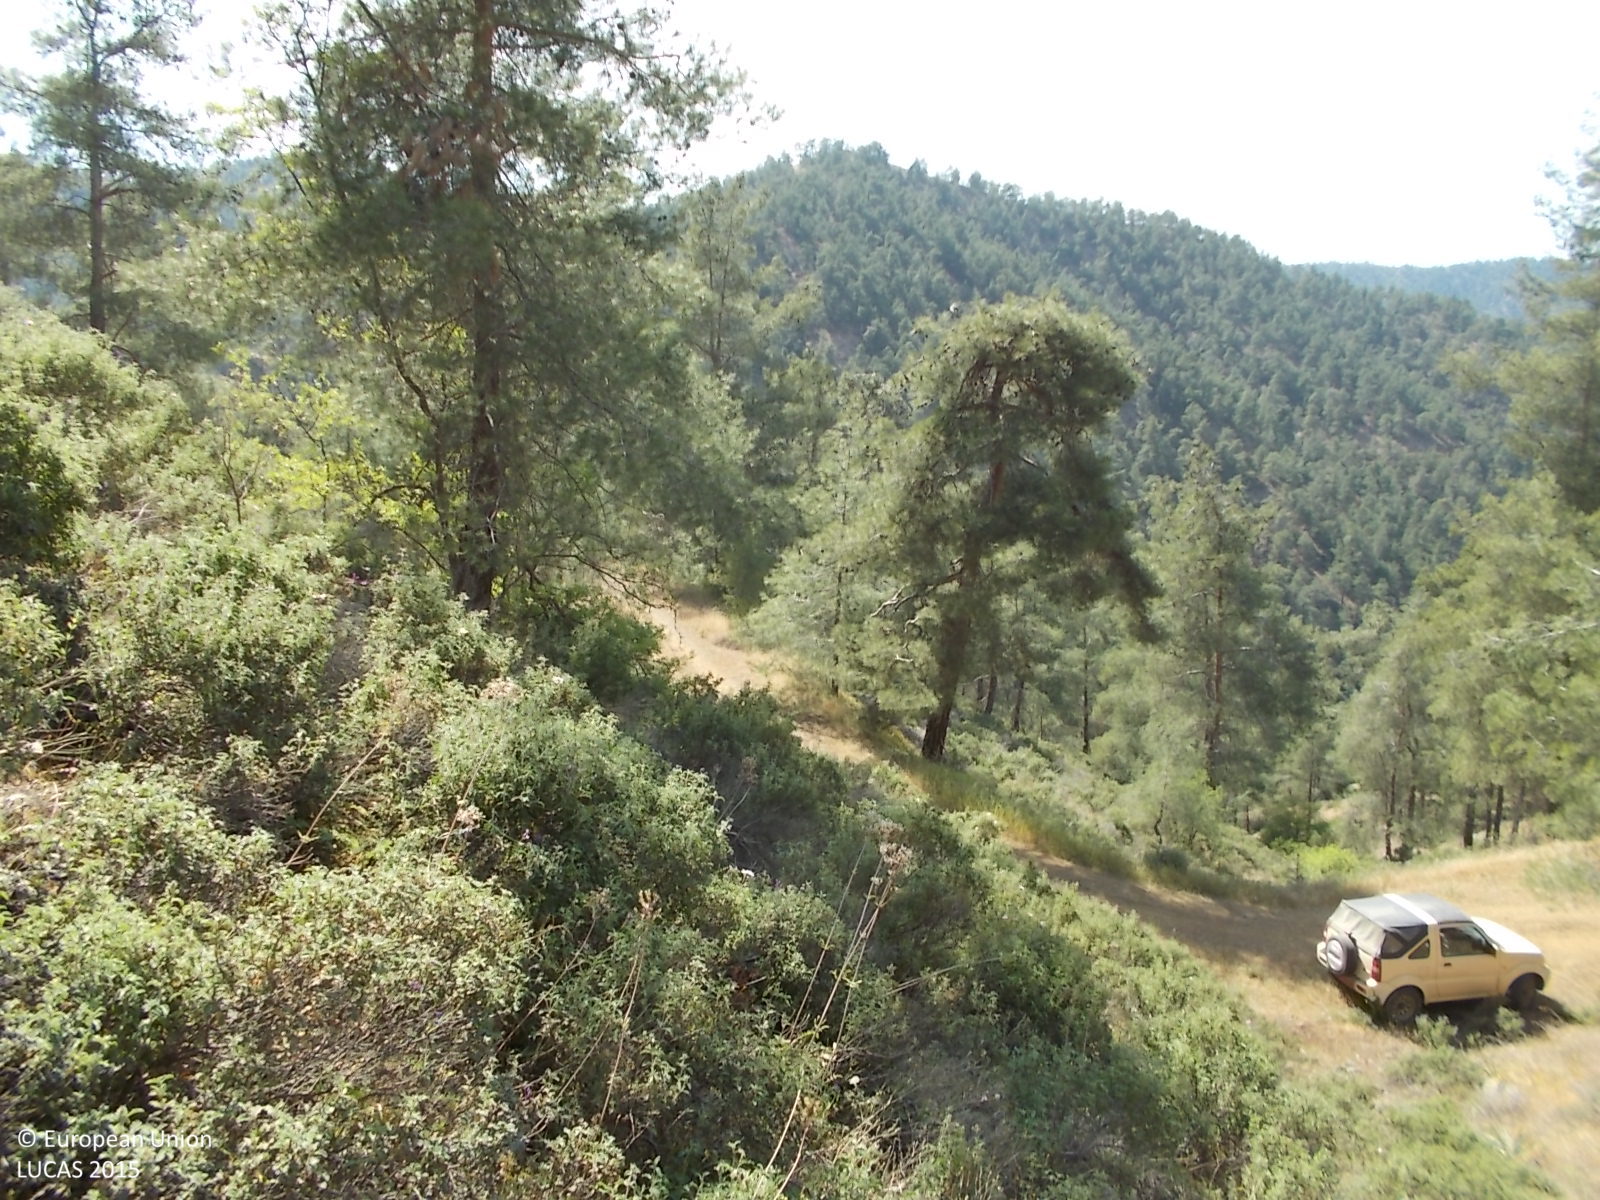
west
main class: Woodland
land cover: Pine dominated coniferous woodland
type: coniferous forest of the mediterranean region
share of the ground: 10 - 25 %
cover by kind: shrubs 40 %, herbaceous plants 35 %, coniferous forest trees 15 %, unconsolidated bare surface 10 %
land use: Forestry
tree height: > 5 m
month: May
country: CY
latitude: 34.9795
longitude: 33.0812
